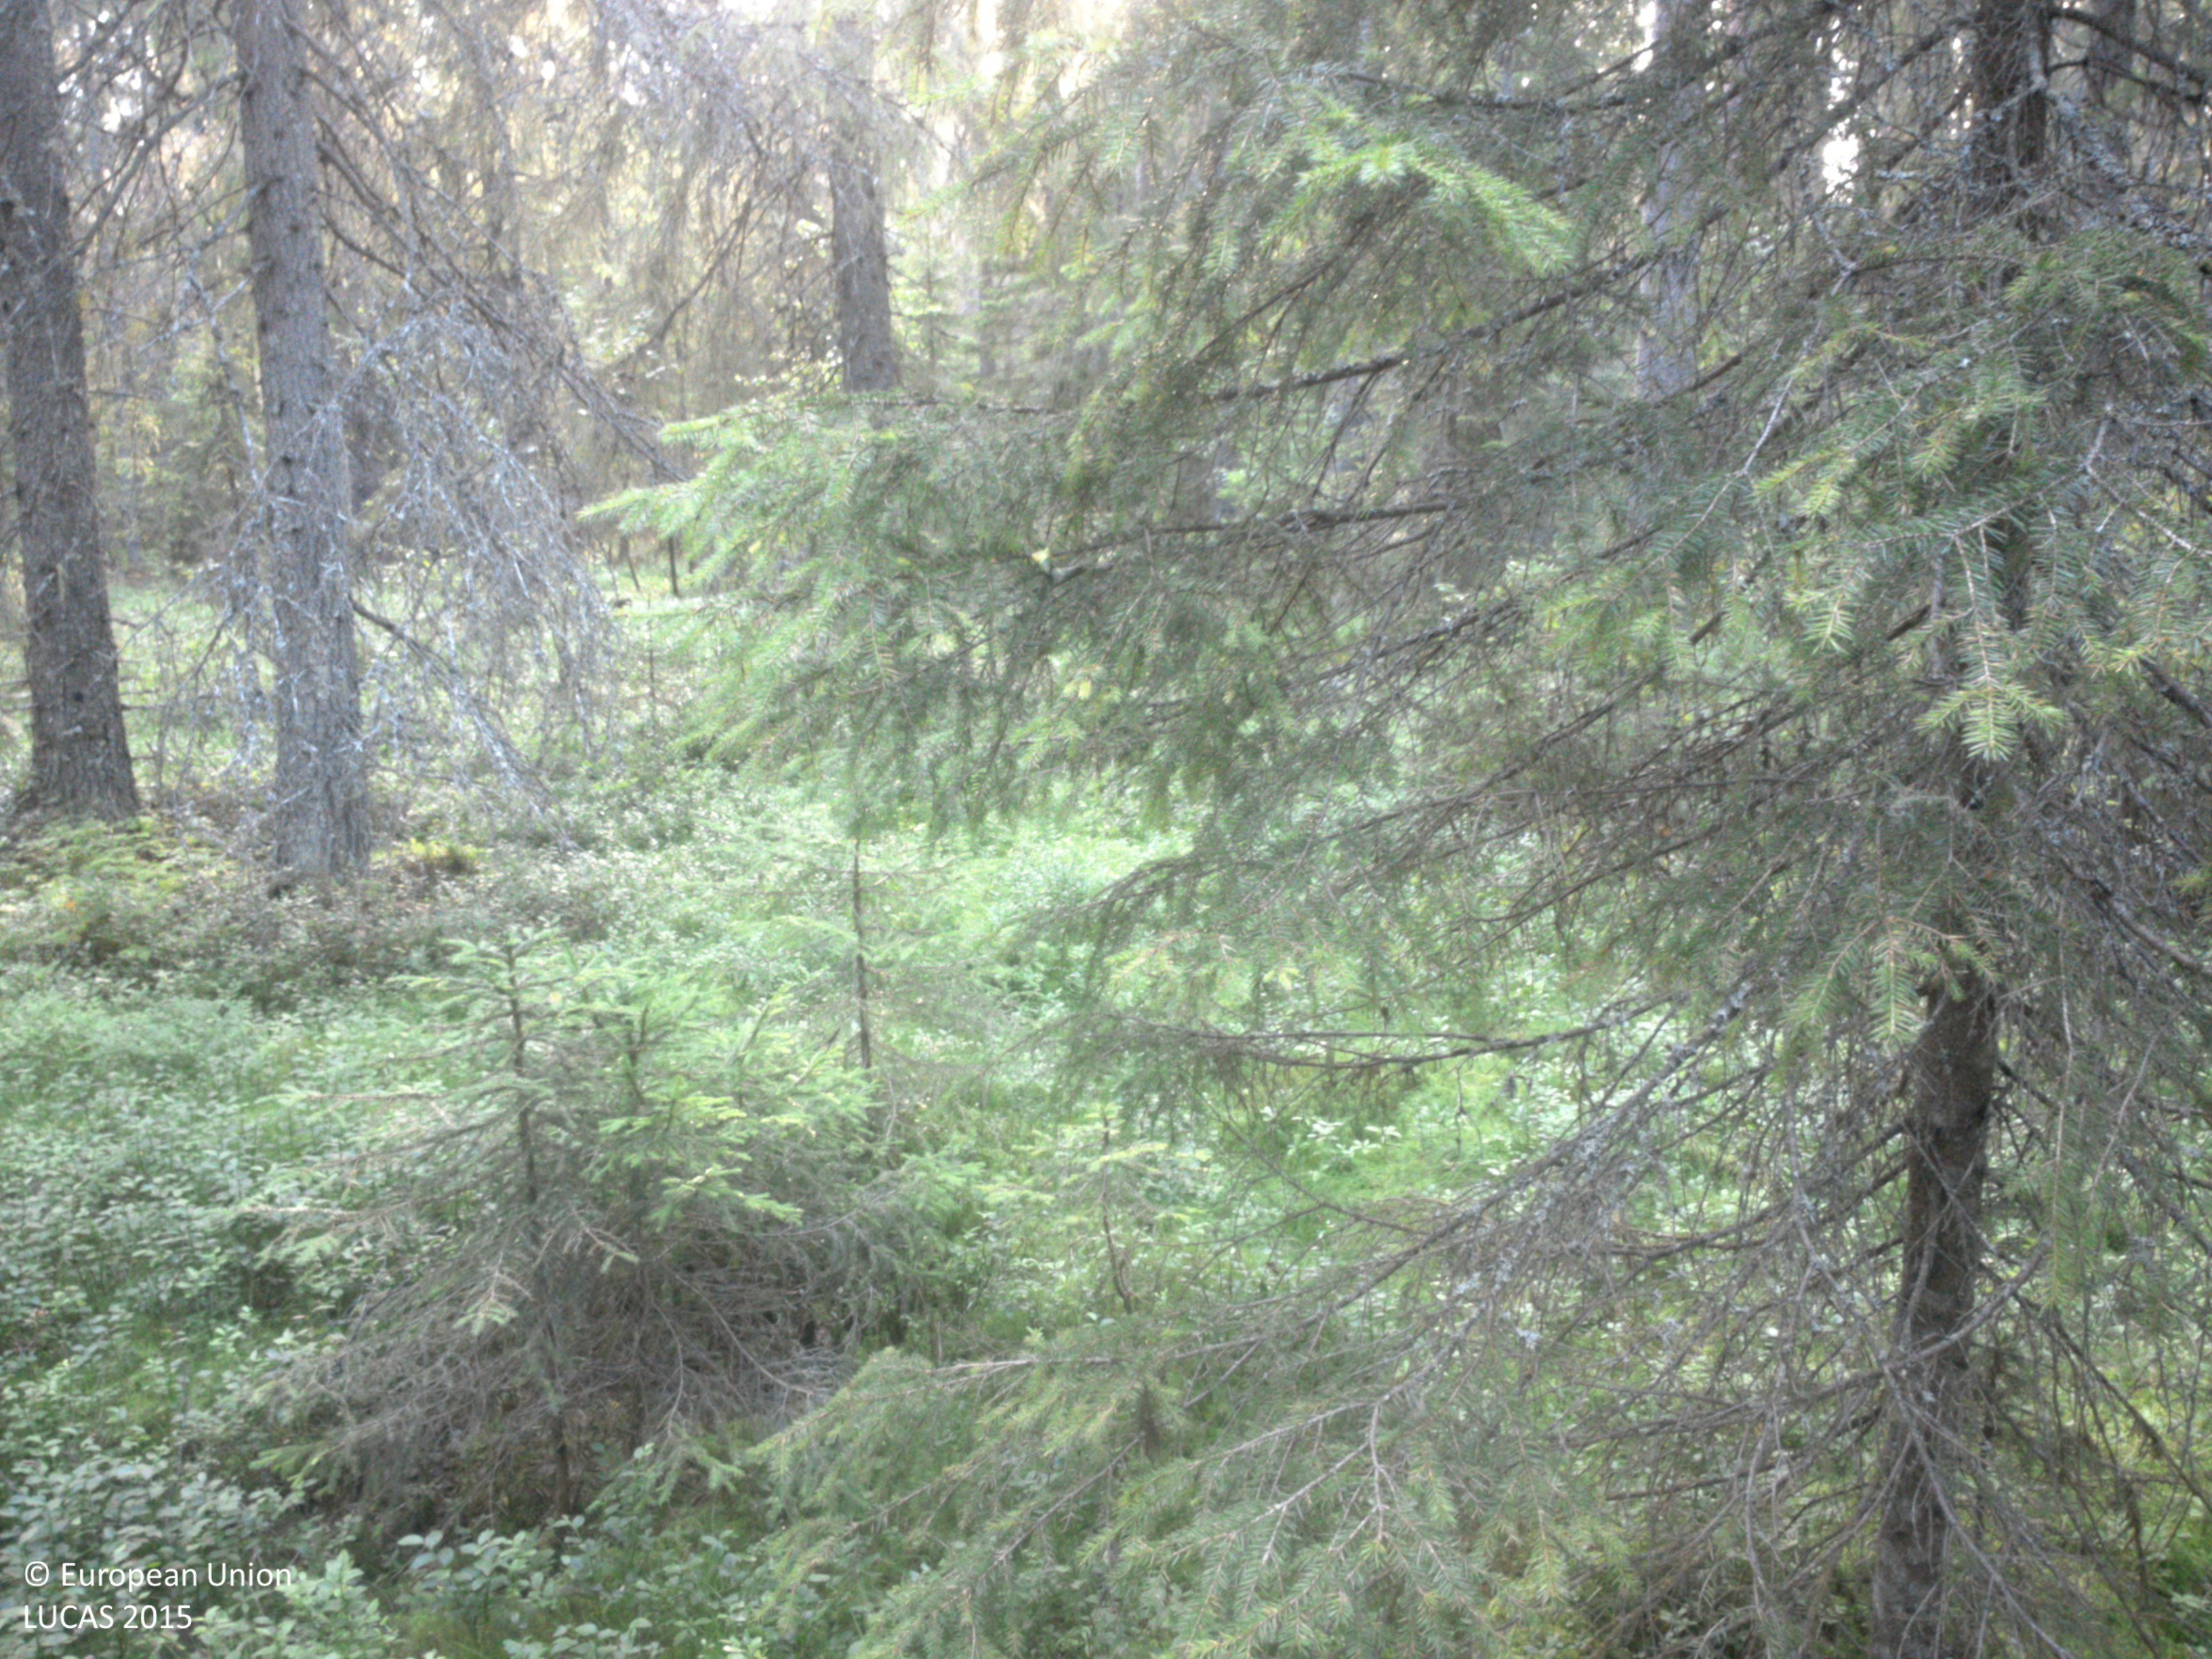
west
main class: Woodland
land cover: Spruce dominated coniferous woodland
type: boreal forest
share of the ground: 50 - 75 %
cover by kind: coniferous forest trees 60 %, shrubs 40 %
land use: Forestry
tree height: > 5 m
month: August
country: SE
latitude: 63.7326
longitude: 19.7616
